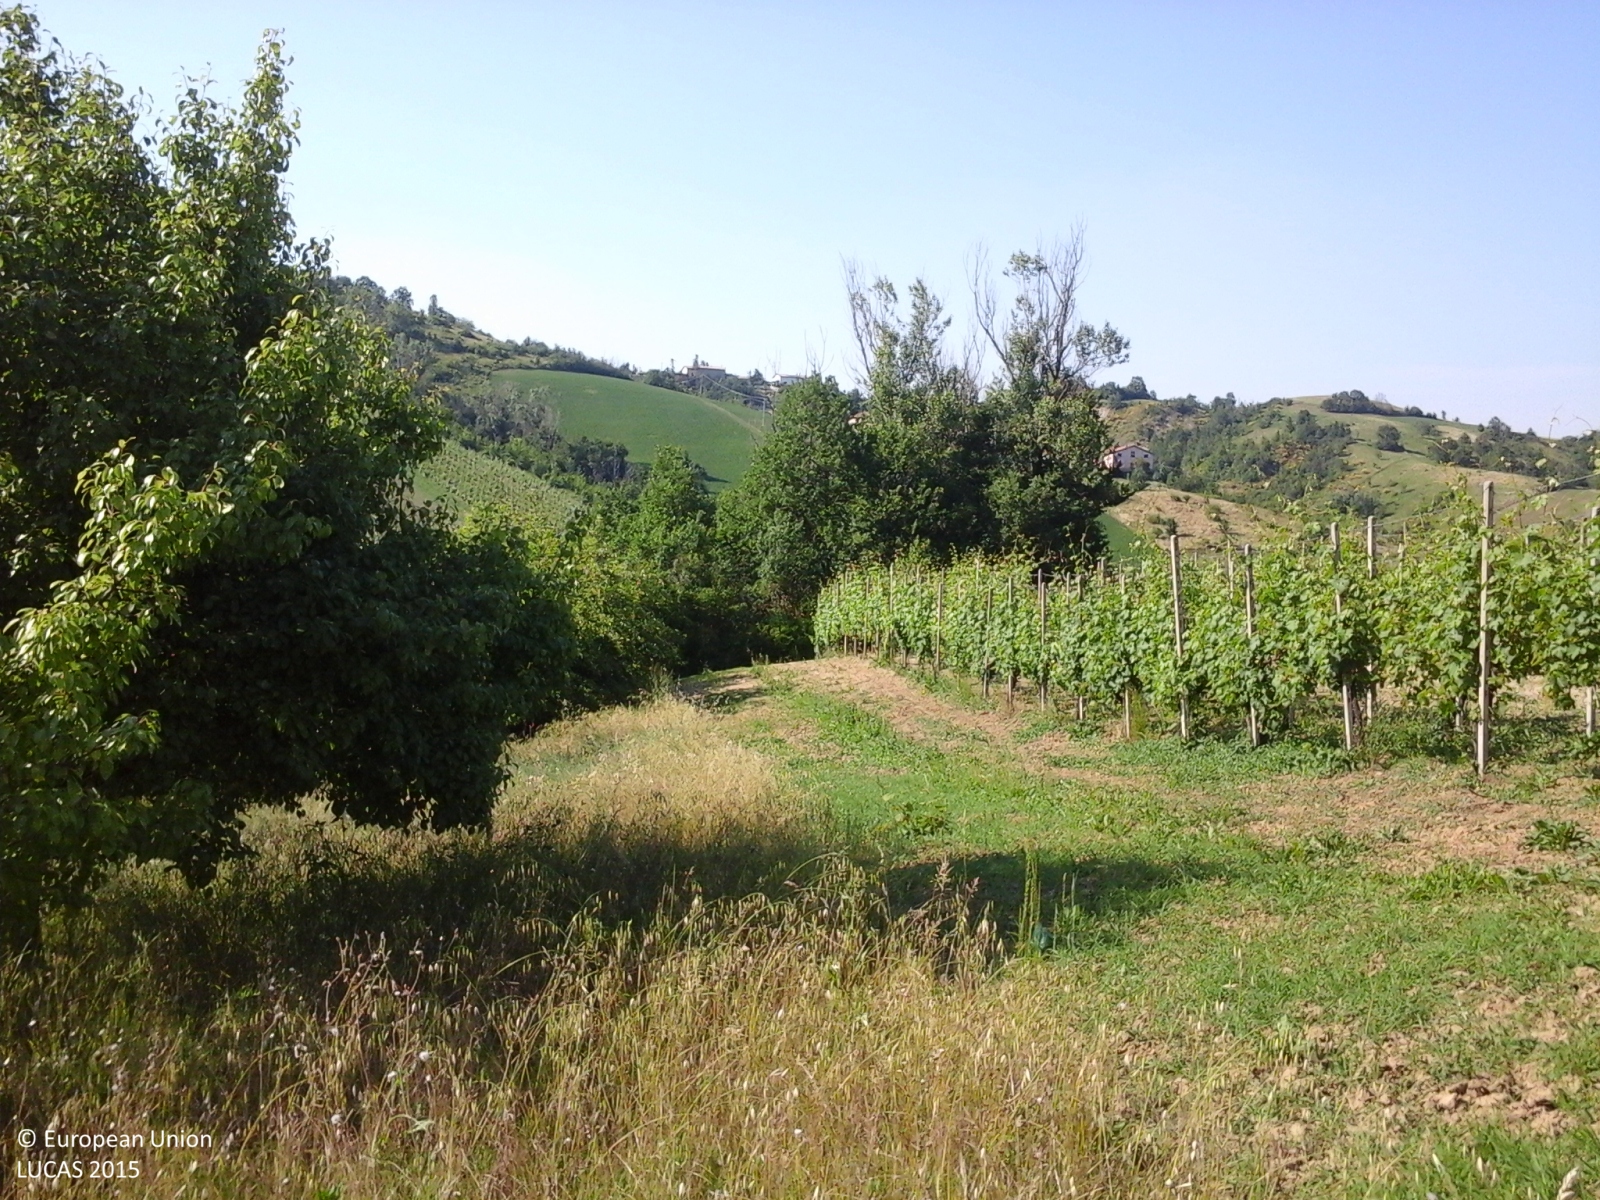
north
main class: Cropland
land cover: Other fruit trees and berries
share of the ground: 10 - 25 %
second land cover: Grassland without tree/shrub cover
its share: > 75 %
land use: Agriculture (excluding fallow land and kitchen gardens)
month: June
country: IT
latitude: 44.8193
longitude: 9.8612
